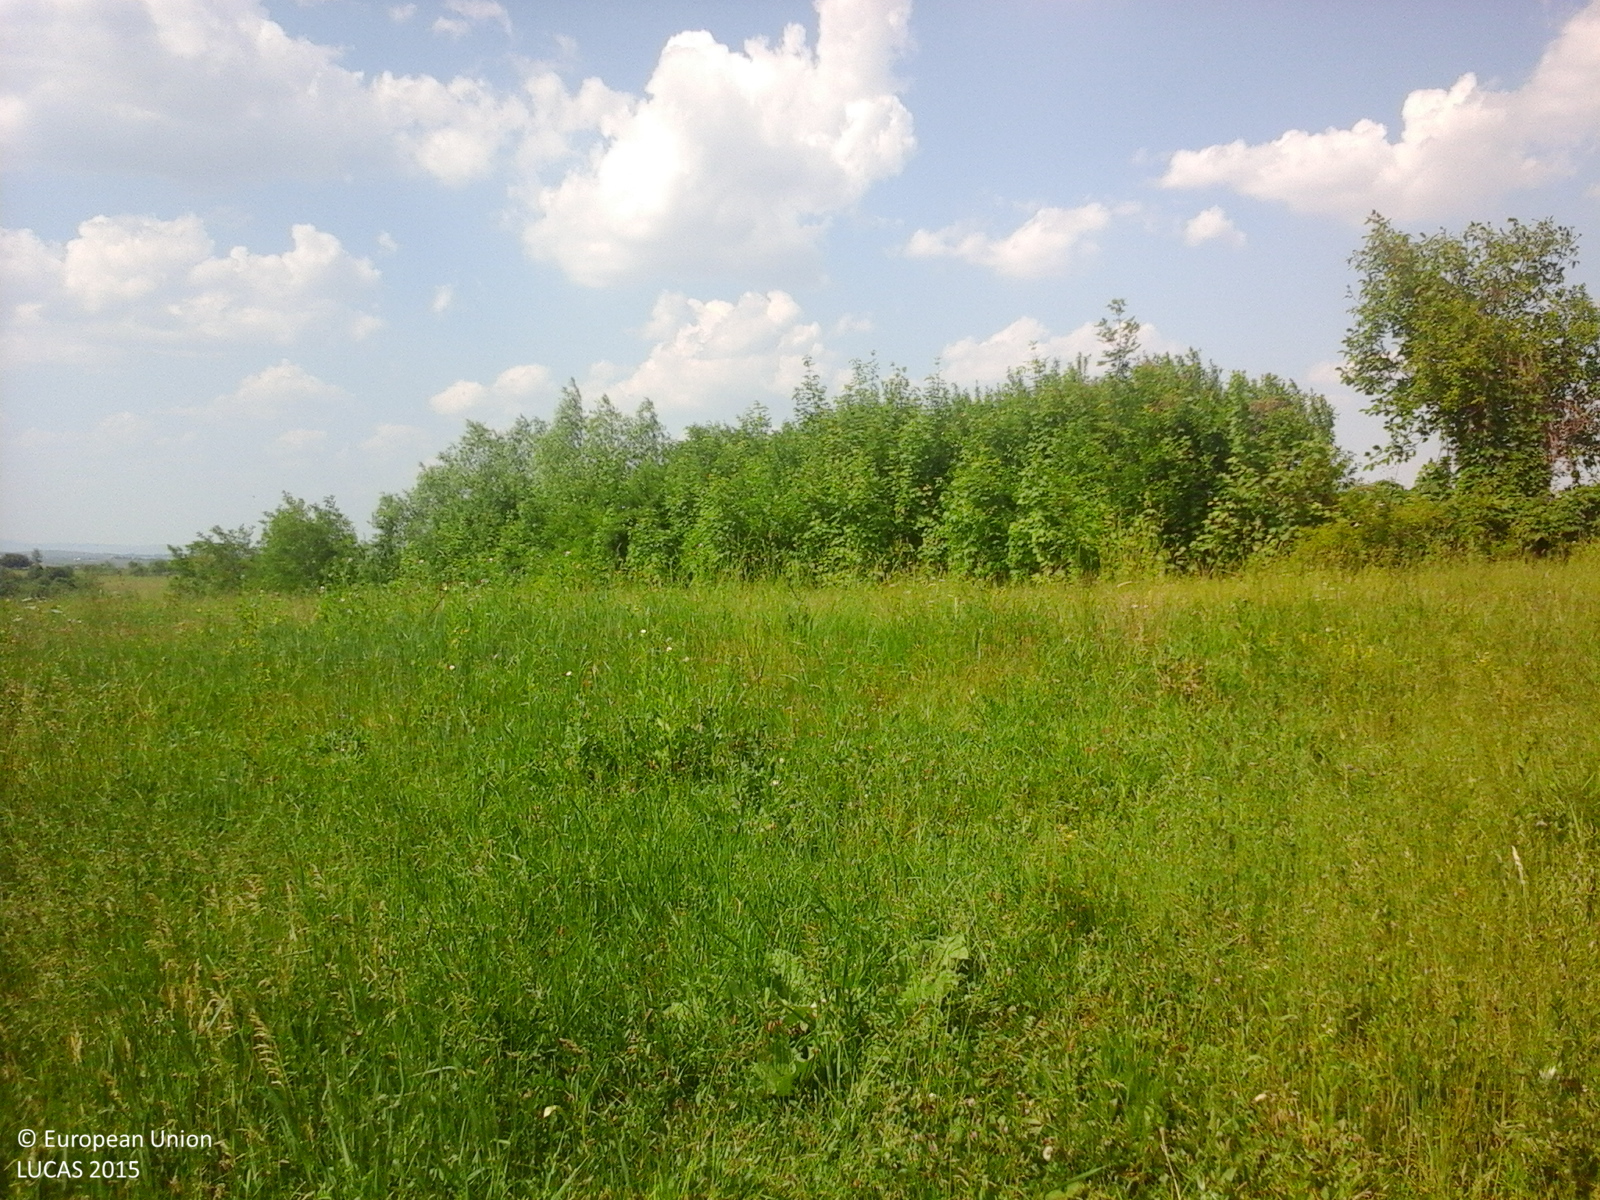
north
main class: Grassland
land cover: Grassland without tree/shrub cover
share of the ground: > 75 %
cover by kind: herbaceous plants 100 %
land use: Agriculture (excluding fallow land and kitchen gardens)
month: June
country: RO
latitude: 46.7251
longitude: 26.5314
